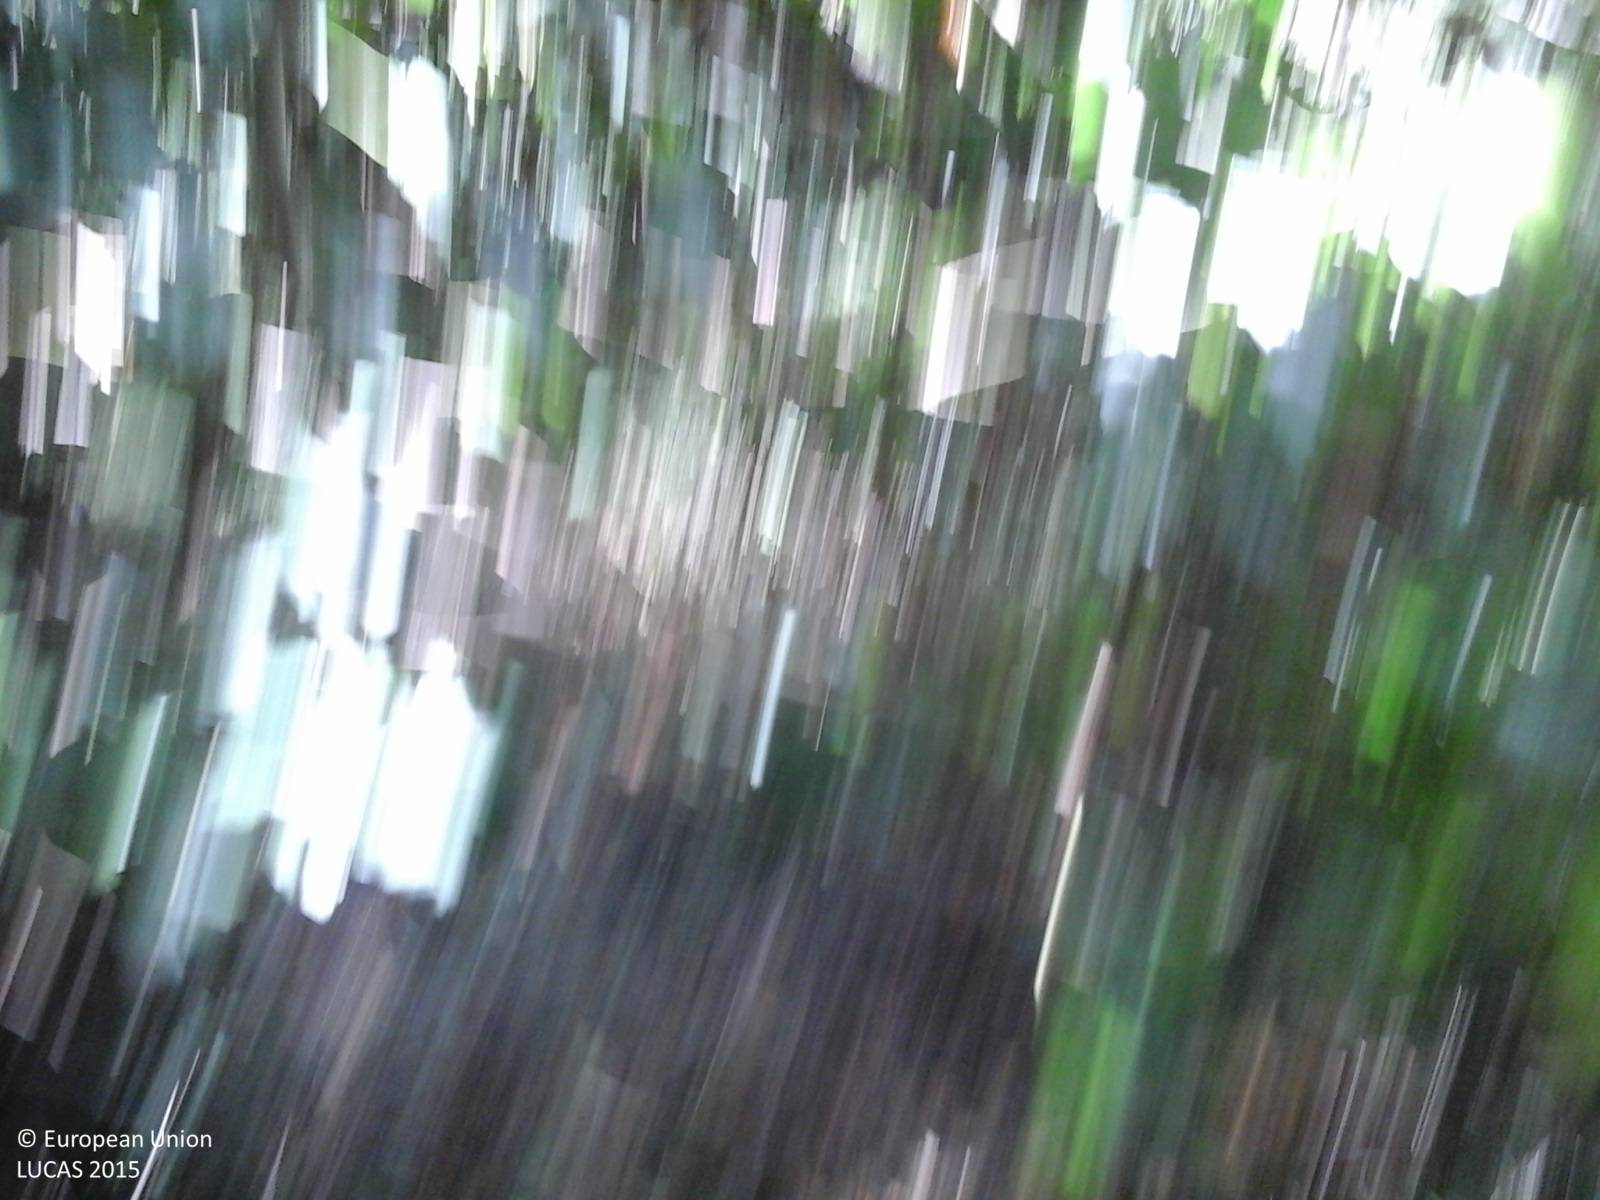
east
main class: Woodland
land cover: Broadleaved woodland
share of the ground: > 75 %
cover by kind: broadleaved forest trees 80 %, shrubs 20 %
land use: Forestry
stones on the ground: < 10 %
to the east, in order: Broadleaved woodland; Inland fresh running water; Broadleaved woodland; Electric lines; Broadleaved woodland; Grassland without tree/shrub cover; Broadleaved woodland
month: September
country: IT
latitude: 42.9757
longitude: 12.0905
